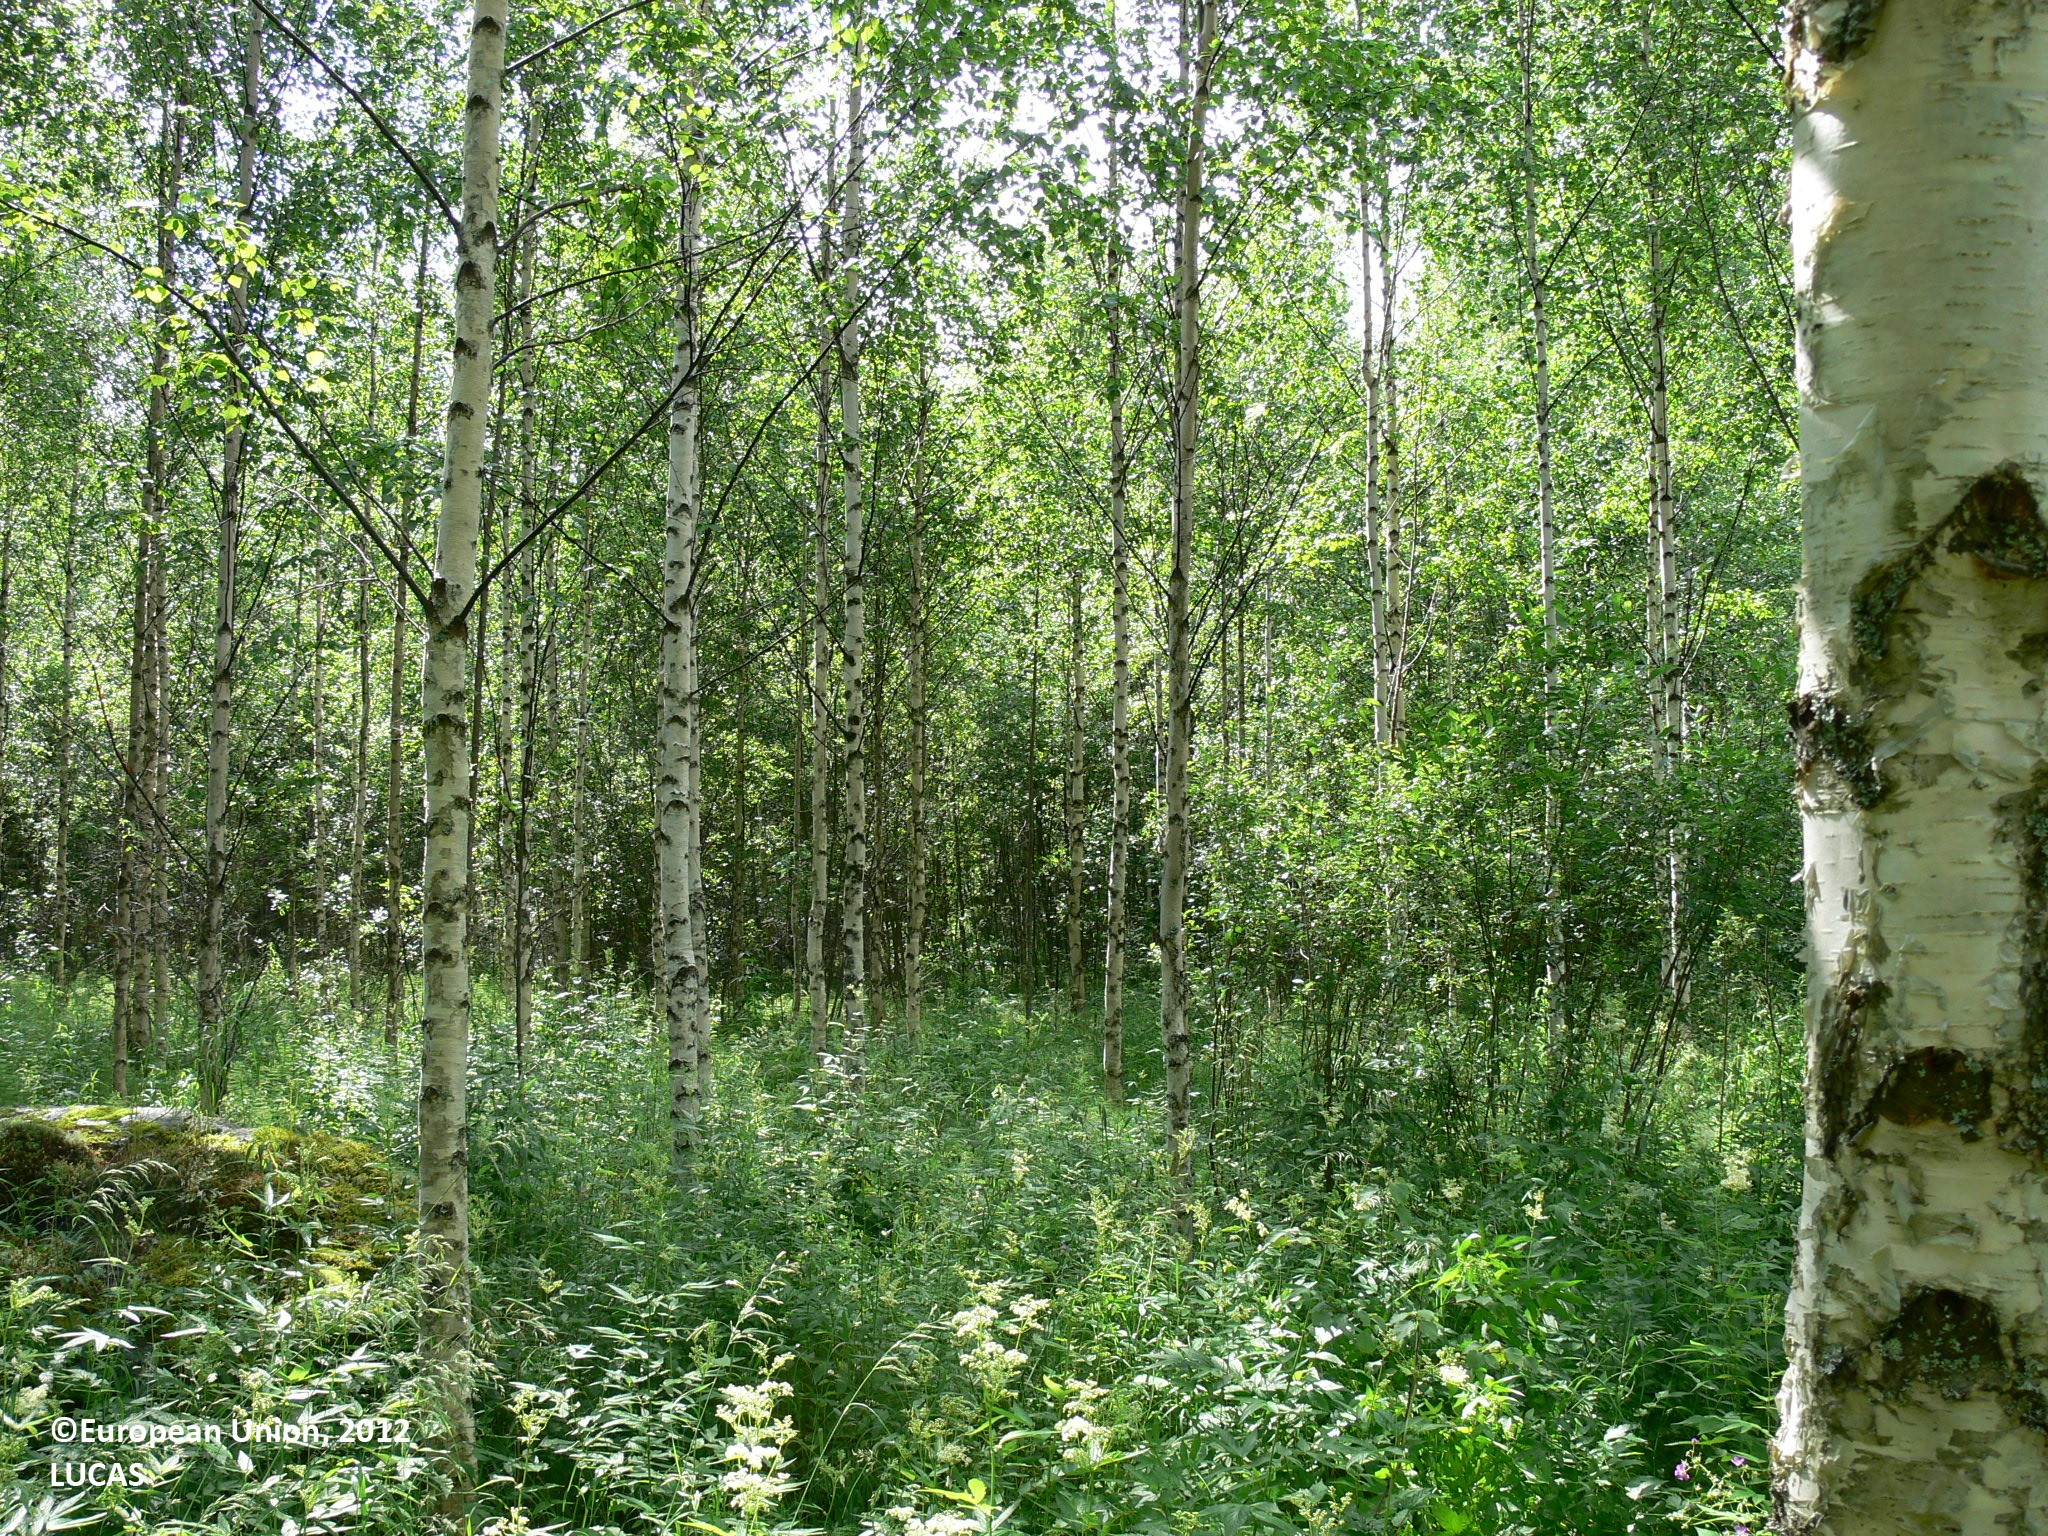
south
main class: Woodland
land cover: Broadleaved woodland
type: boreal forest
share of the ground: > 75 %
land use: Forestry
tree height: > 5 m
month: July
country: FI
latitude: 63.1967
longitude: 29.9897
